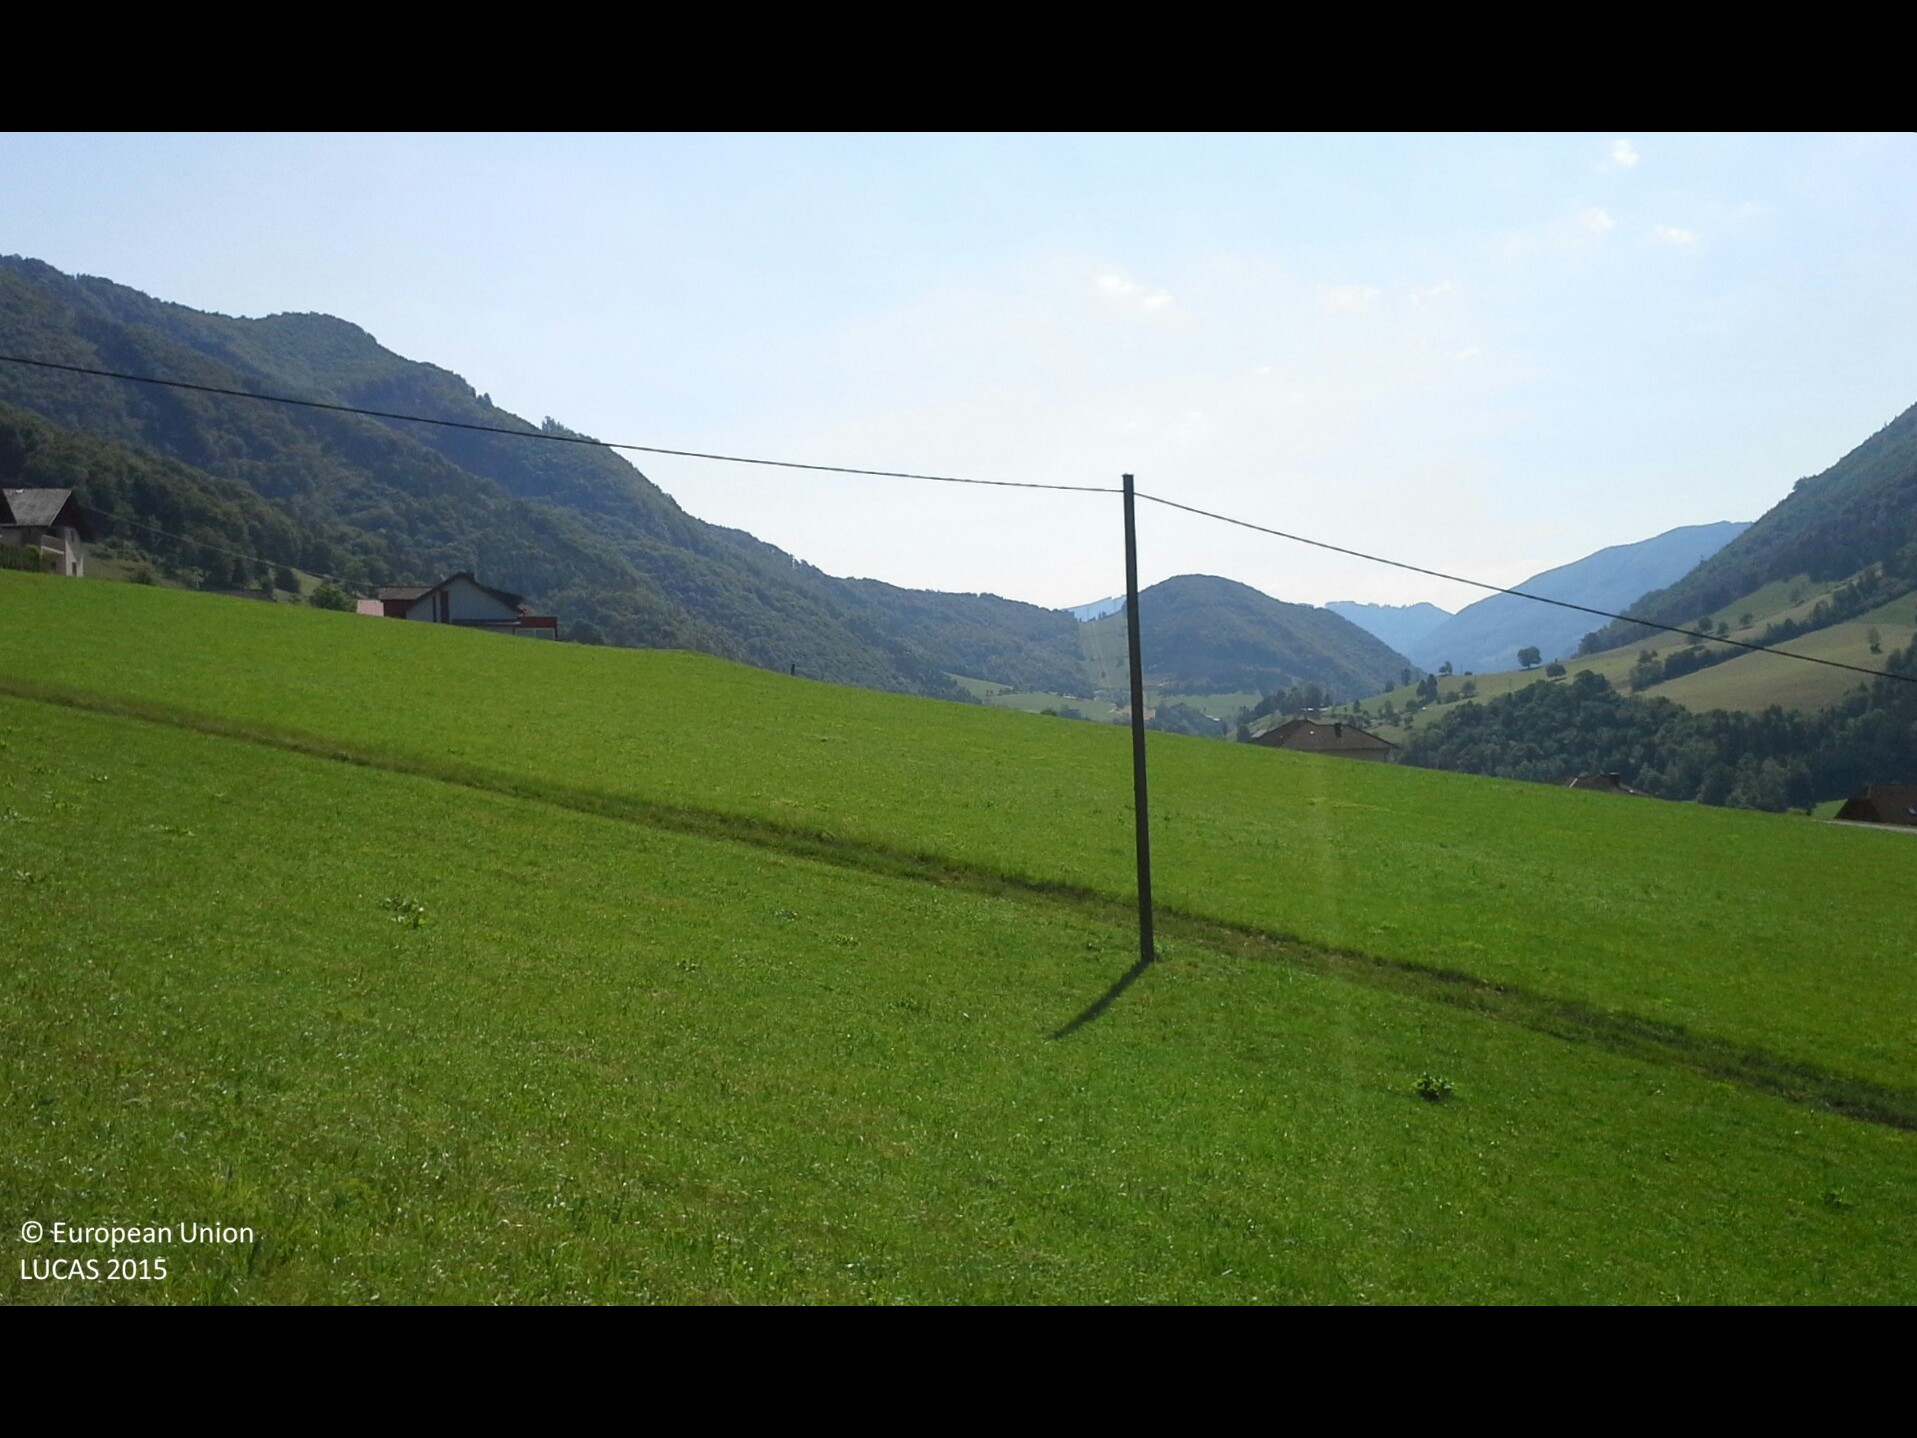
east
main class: Grassland
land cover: Grassland without tree/shrub cover
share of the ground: > 75 %
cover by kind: herbaceous plants 100 %
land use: Agriculture (excluding fallow land and kitchen gardens)
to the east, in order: Grassland without tree/shrub cover; Other coniferous woodland; Shrubland with sparse tree cover; Grassland without tree/shrub cover; Fences; Grassland without tree/shrub cover; Electric lines; Grassland without tree/shrub cover; Tracks; Grassland without tree/shrub cover; Artificial constructions in urban areas
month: June
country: AT
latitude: 47.8982
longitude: 14.4809
